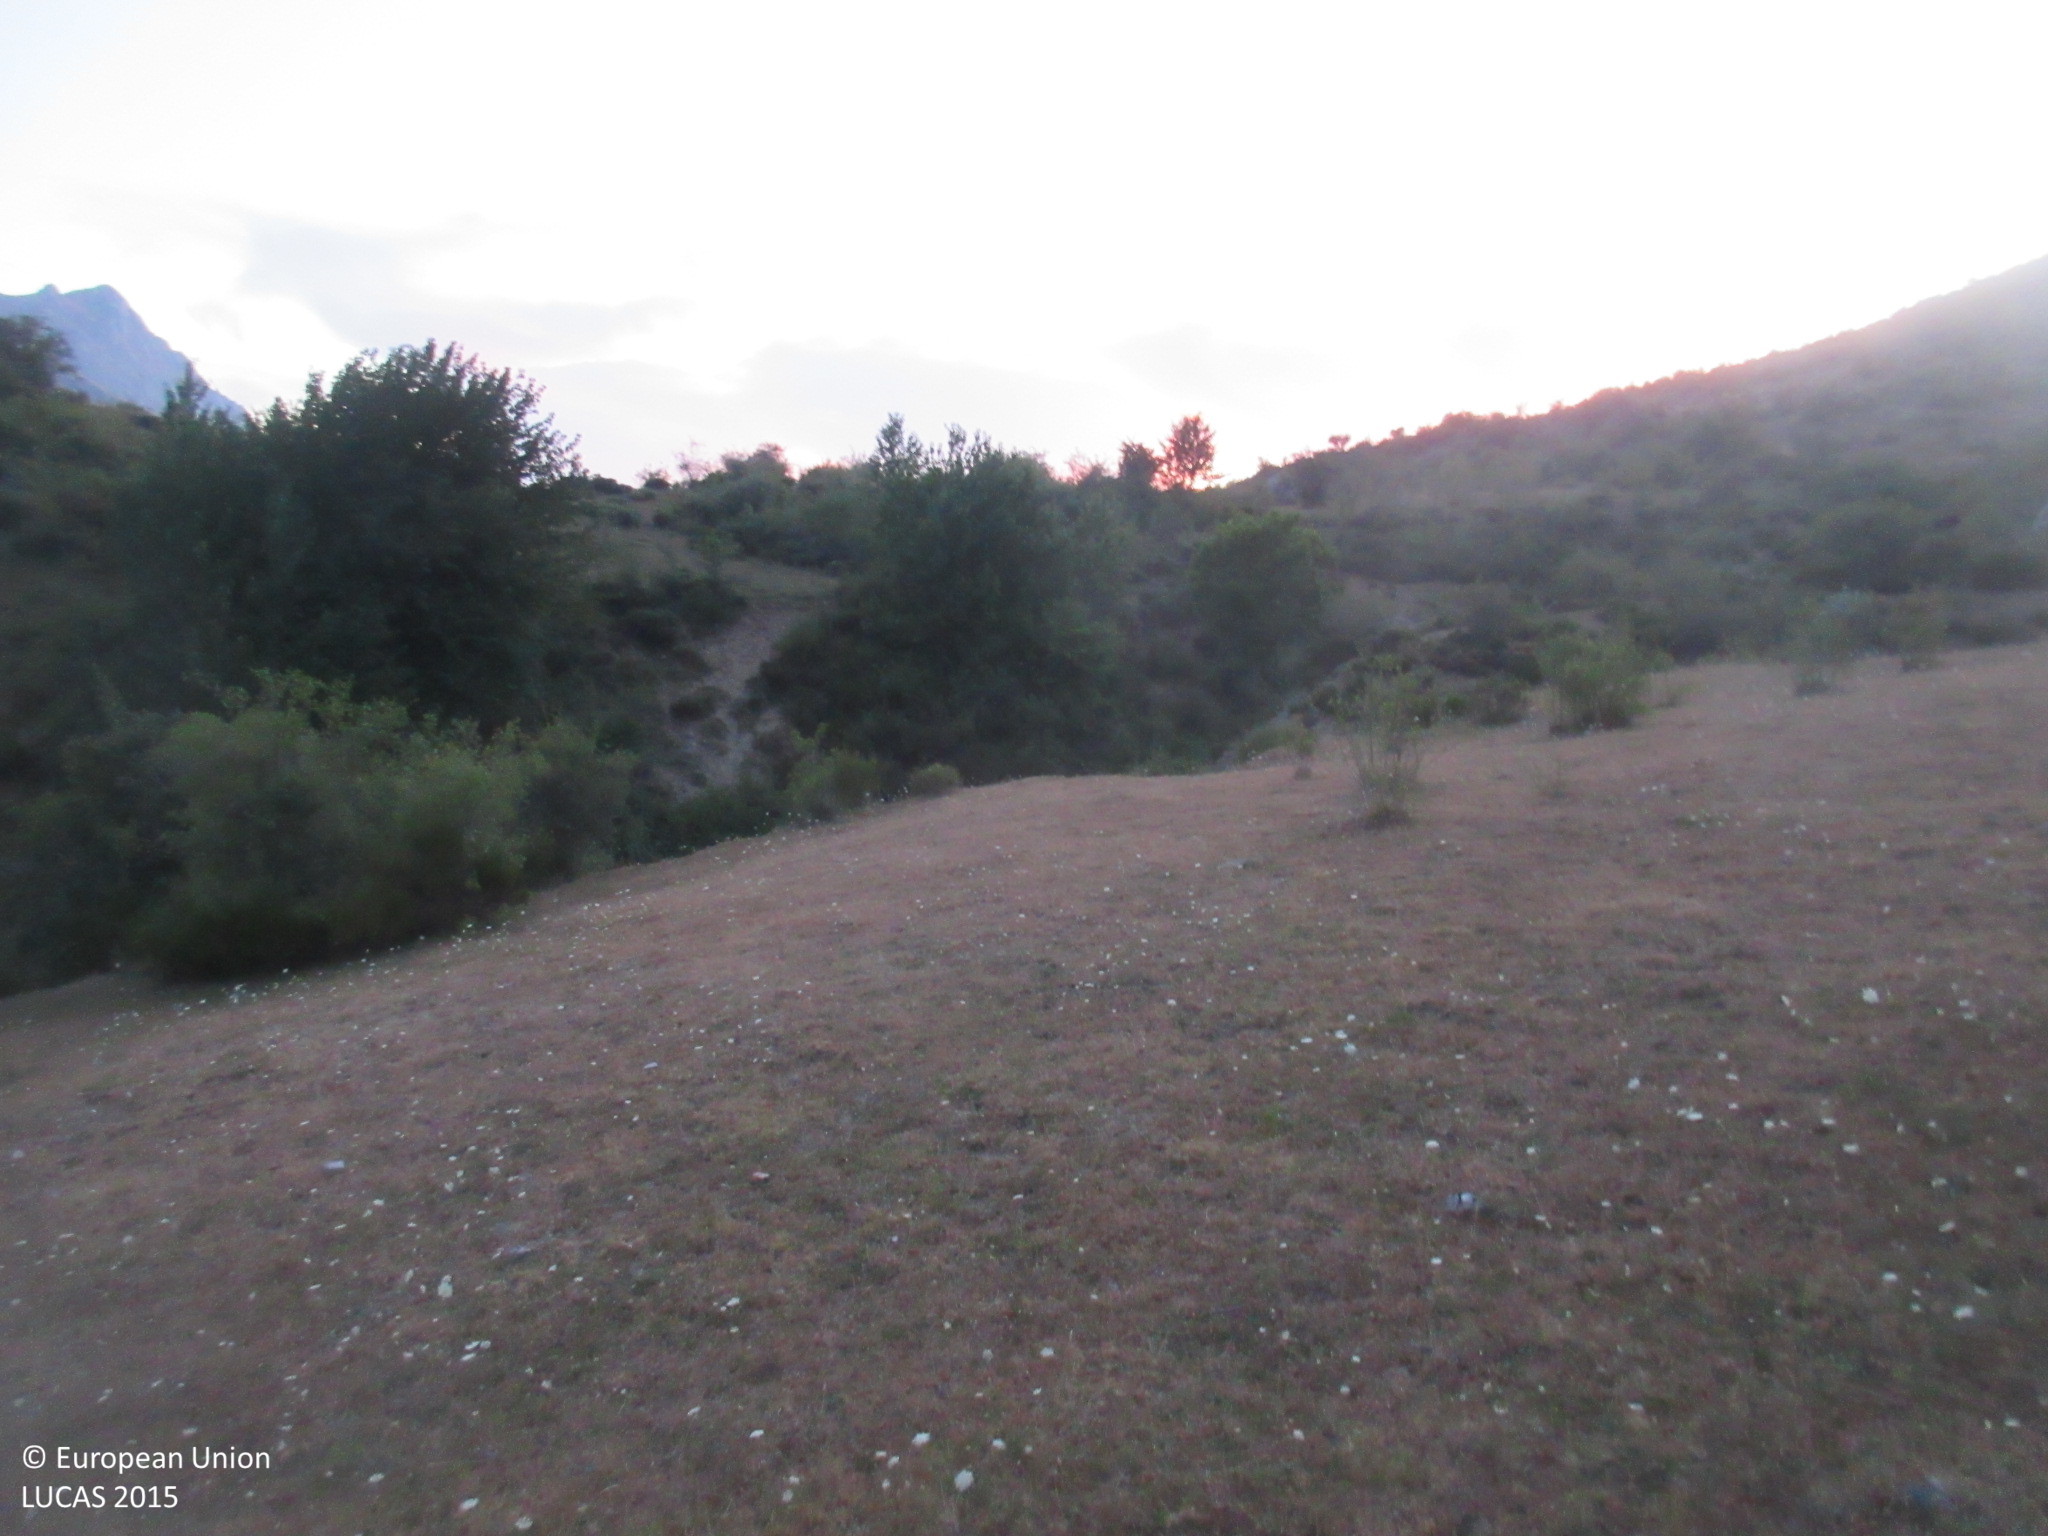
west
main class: Grassland
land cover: Grassland without tree/shrub cover
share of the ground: > 75 %
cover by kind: herbaceous plants 100 %
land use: Agriculture (excluding fallow land and kitchen gardens)
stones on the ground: < 10 %
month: July
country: ES
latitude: 42.9458
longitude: -5.4557
